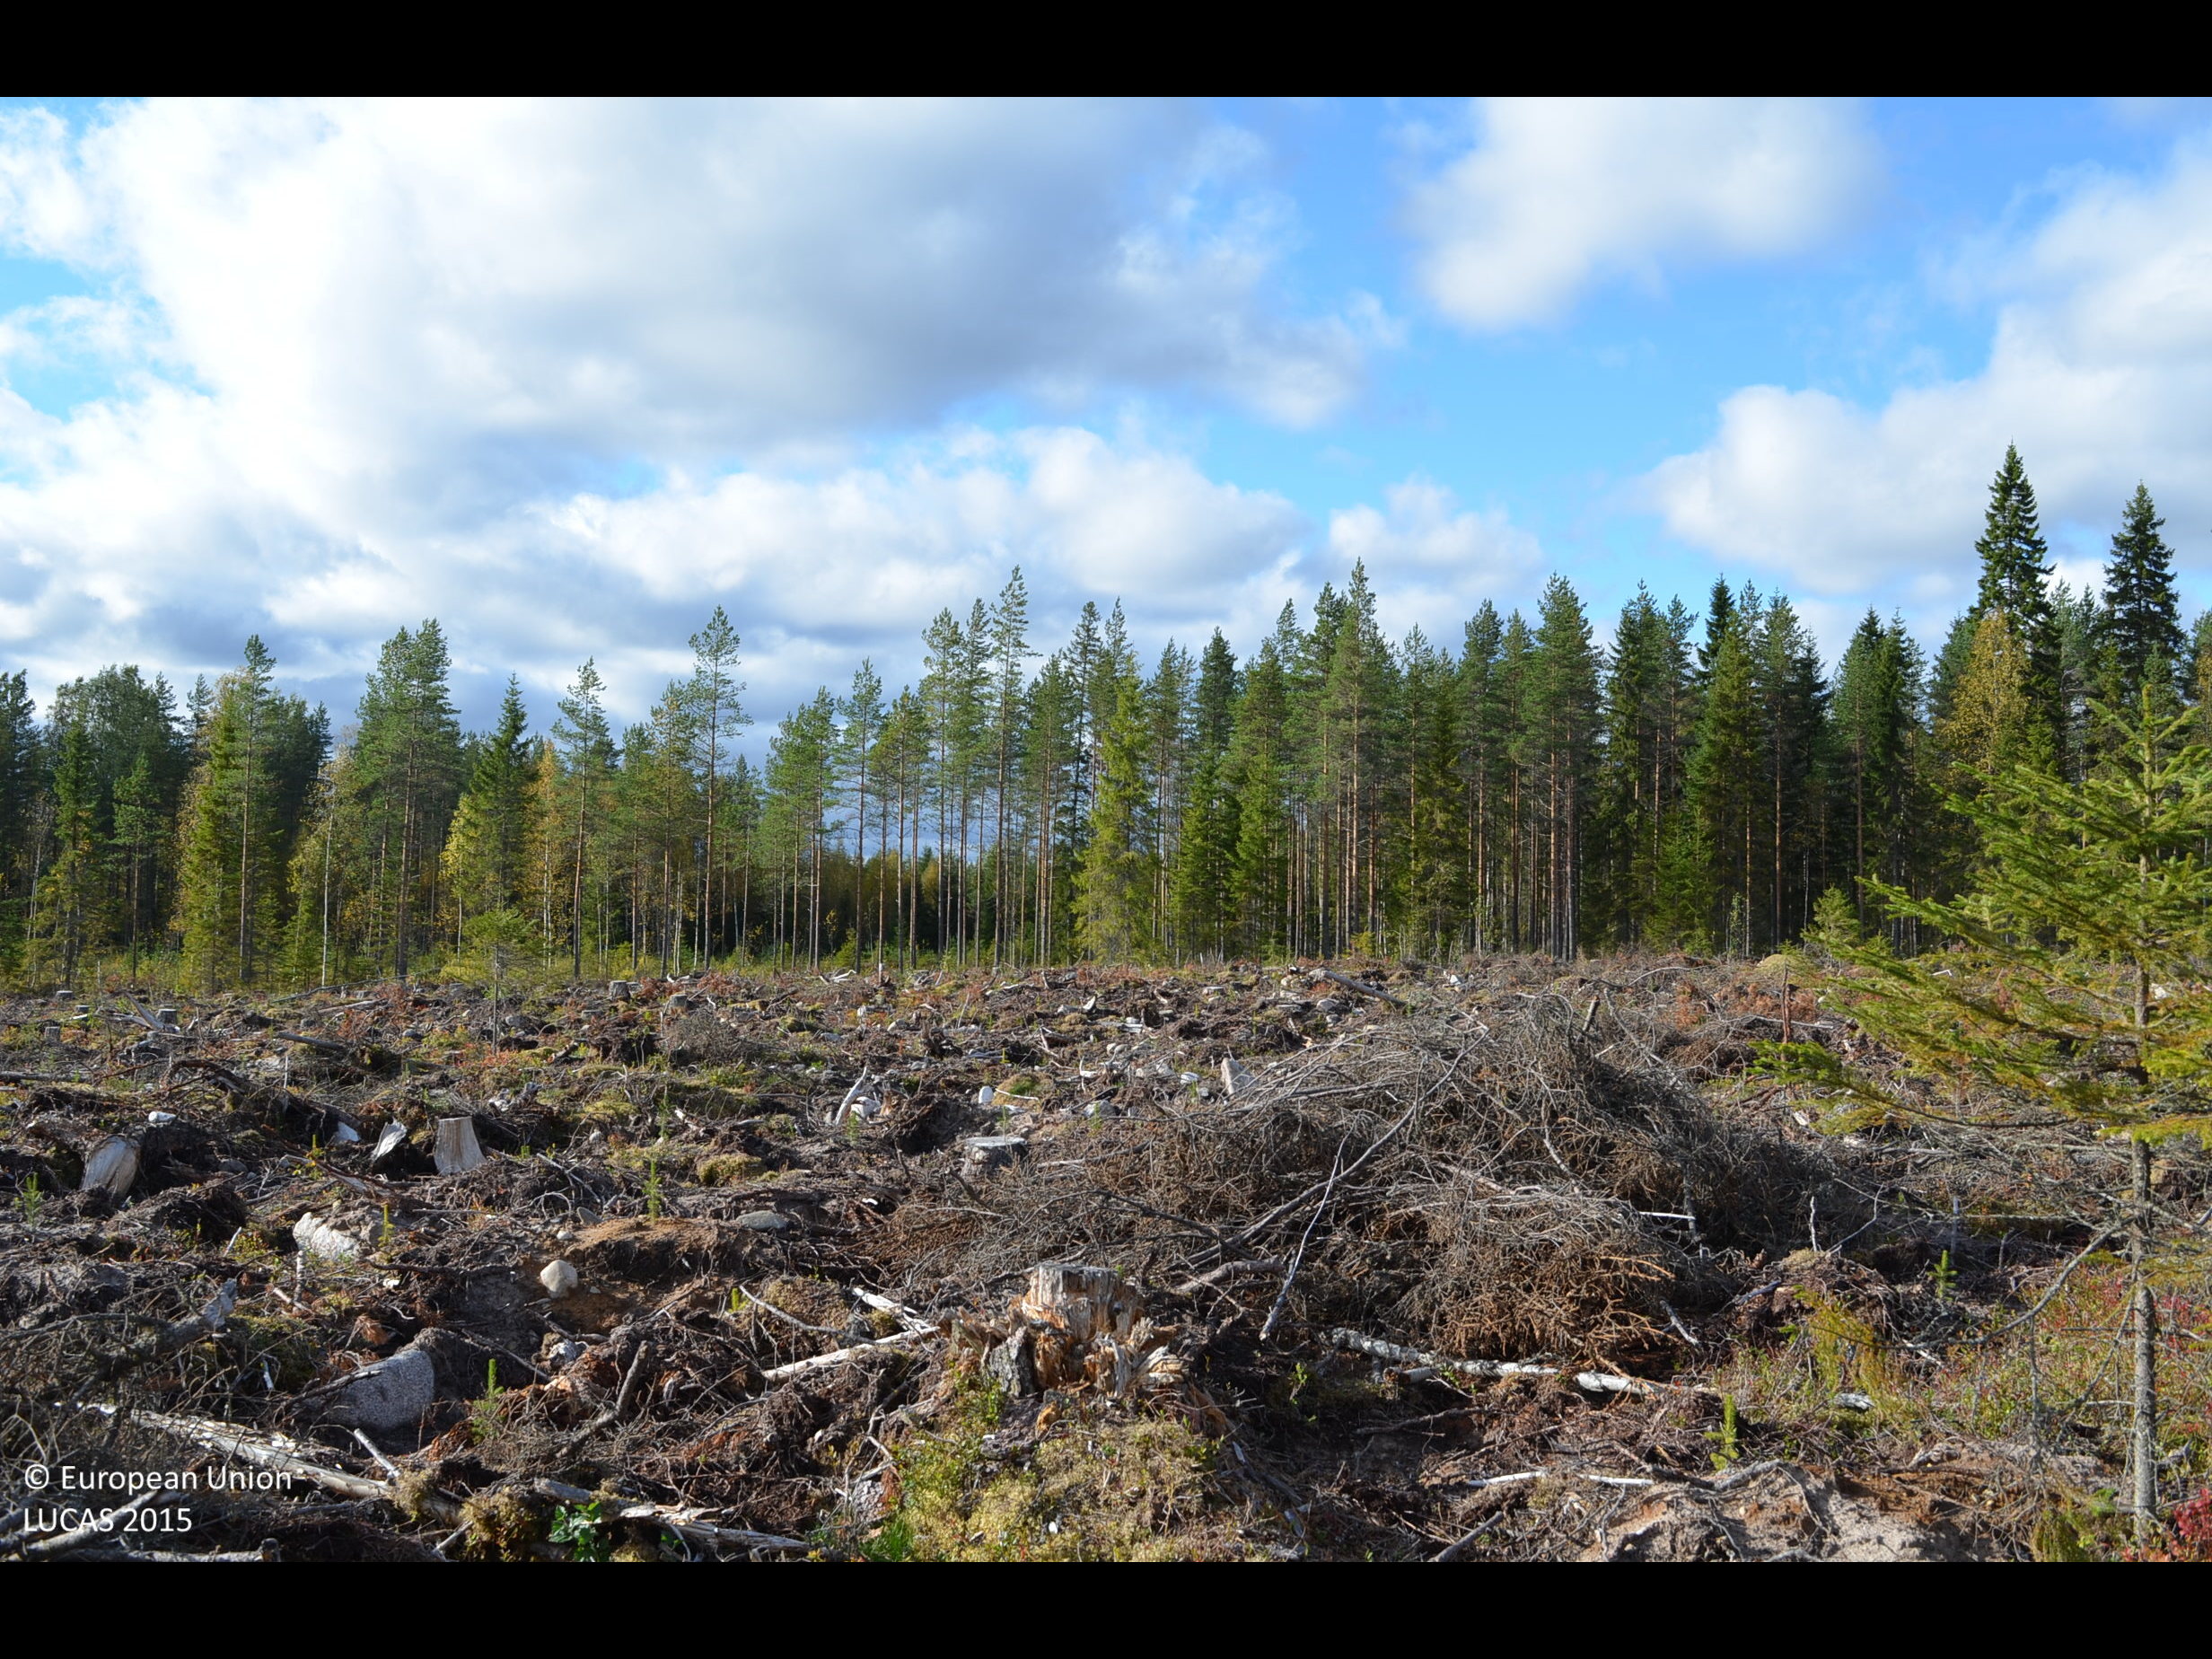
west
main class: Shrubland
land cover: Shrubland without tree cover
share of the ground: 10 - 25 %
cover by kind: unconsolidated bare surface 50 %, shrubs 10 %, lichens and mosses 10 %
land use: Forestry
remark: Clear cut
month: September
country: FI
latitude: 62.9066
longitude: 23.8301
